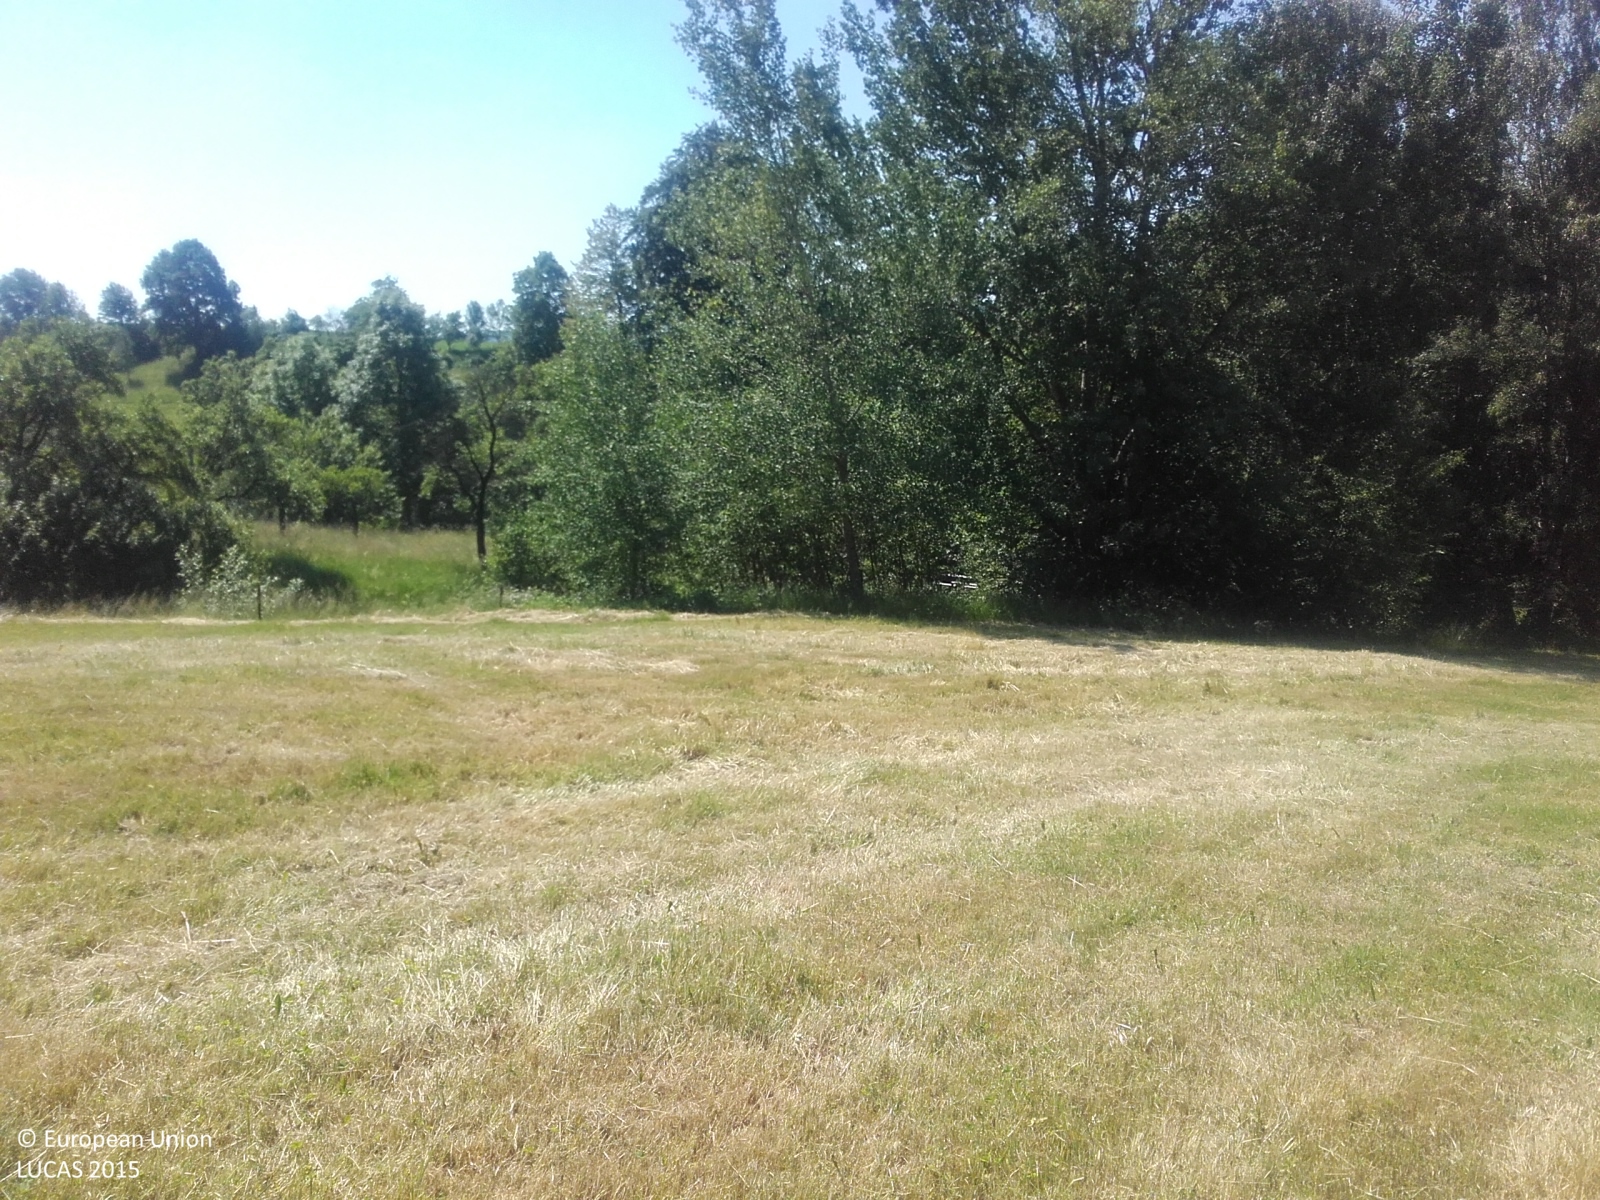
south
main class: Grassland
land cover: Grassland without tree/shrub cover
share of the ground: > 75 %
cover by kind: herbaceous plants 100 %
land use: Agriculture (excluding fallow land and kitchen gardens)
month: June
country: CZ
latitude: 49.5720
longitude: 18.8018
